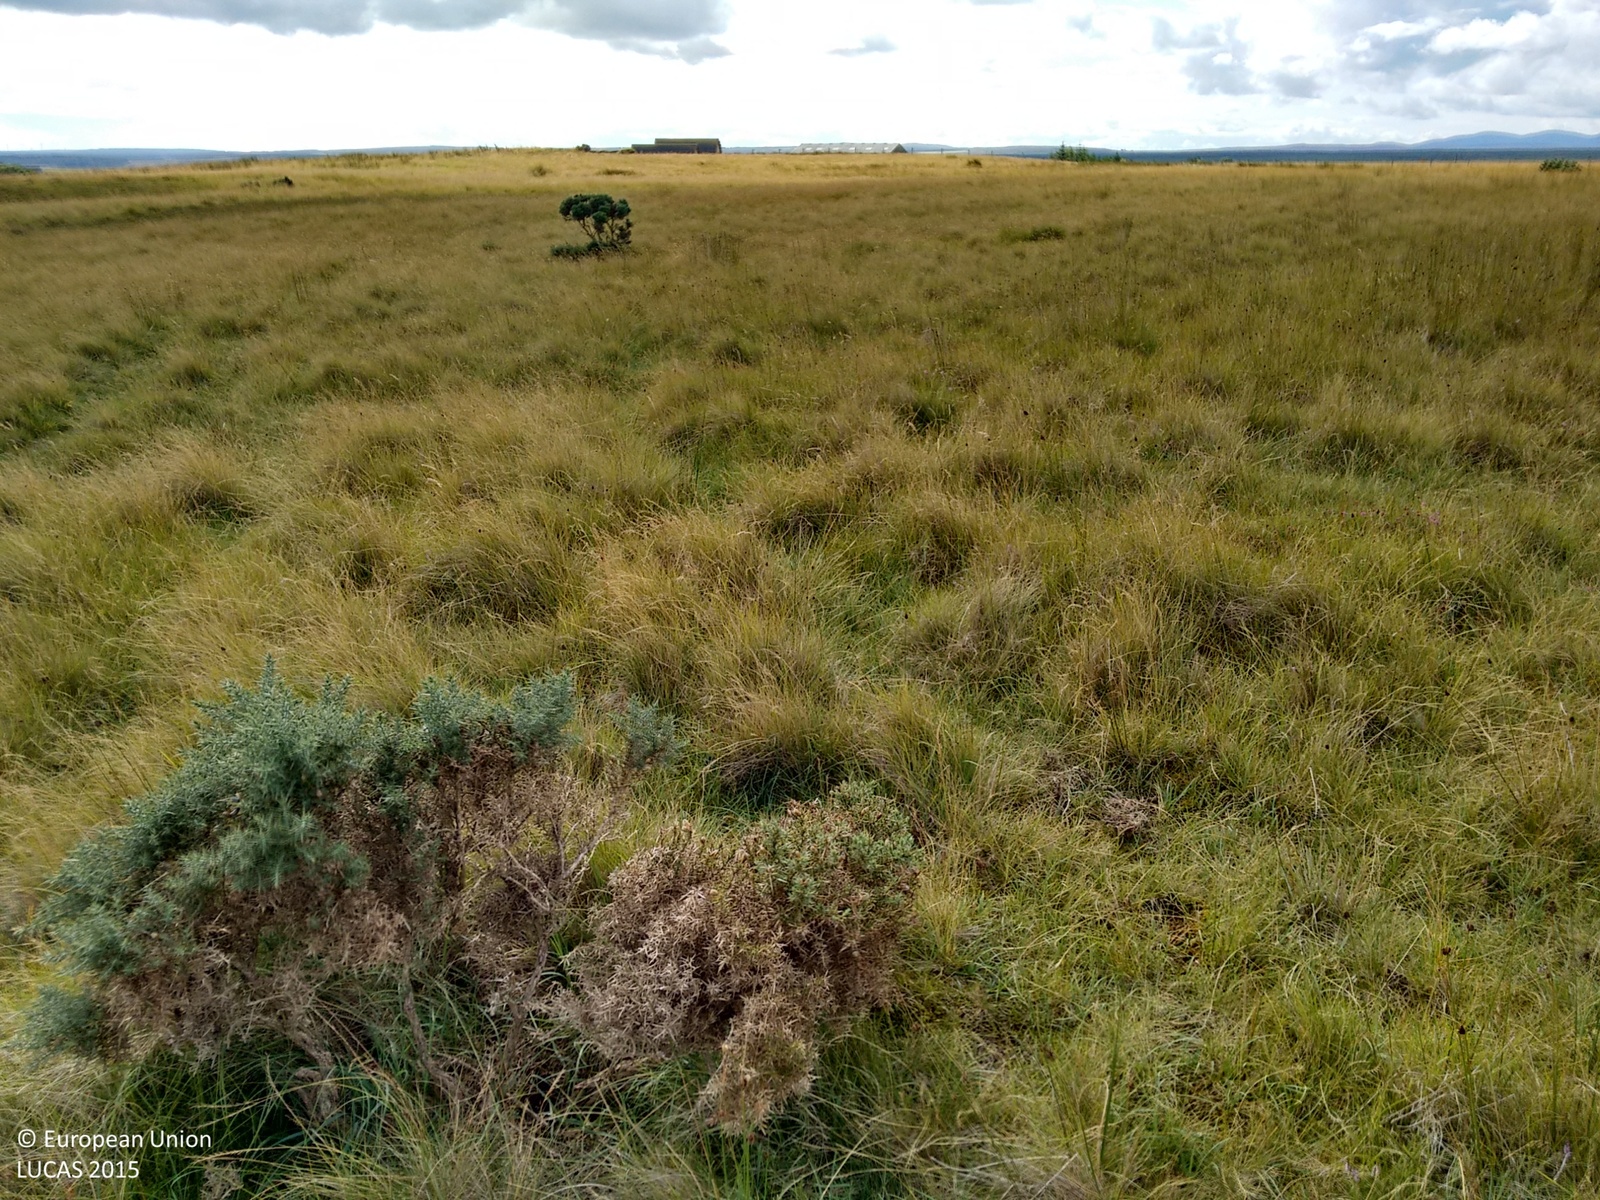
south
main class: Grassland
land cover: Grassland without tree/shrub cover
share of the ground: > 75 %
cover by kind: herbaceous plants 95 %, shrubs 5 %
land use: Agriculture (excluding fallow land and kitchen gardens)
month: August
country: GB
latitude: 58.4778
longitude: -3.3870
